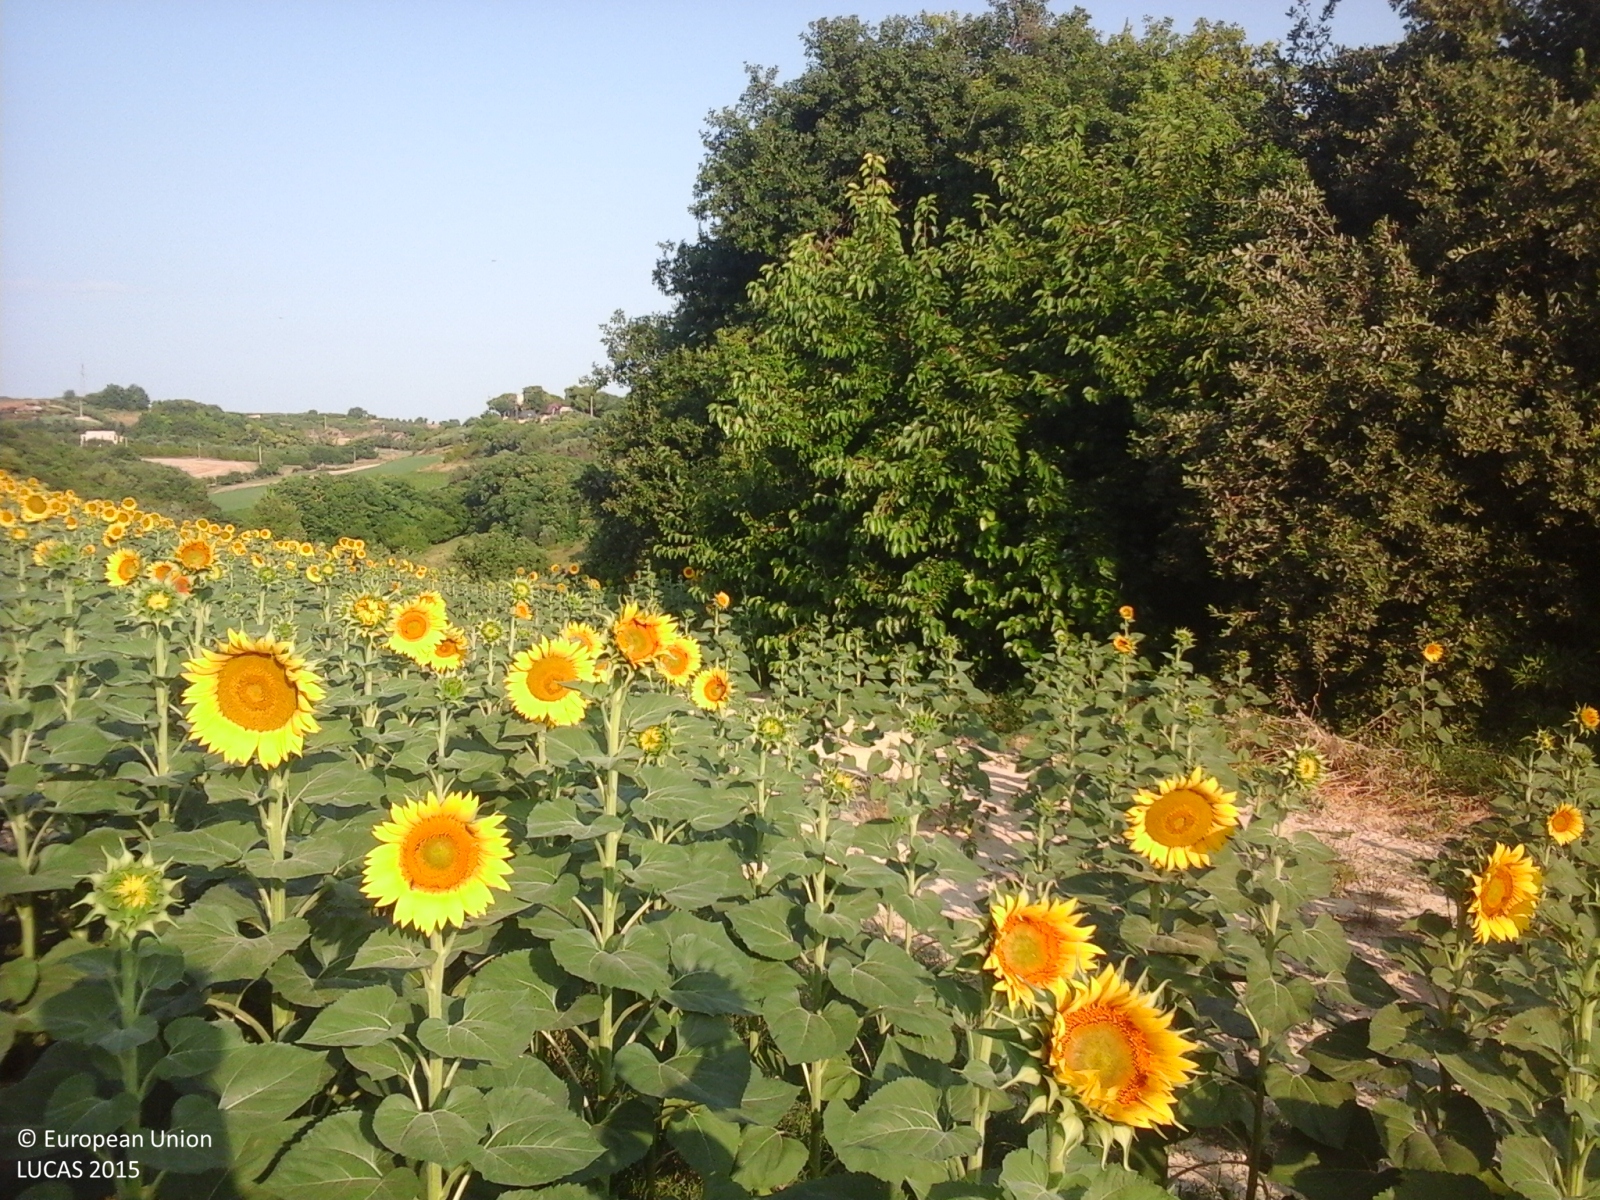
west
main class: Cropland
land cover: Sunflower
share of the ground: > 75 %
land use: Agriculture (excluding fallow land and kitchen gardens)
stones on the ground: < 10 %
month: July
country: IT
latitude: 43.0704
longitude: 13.8093
